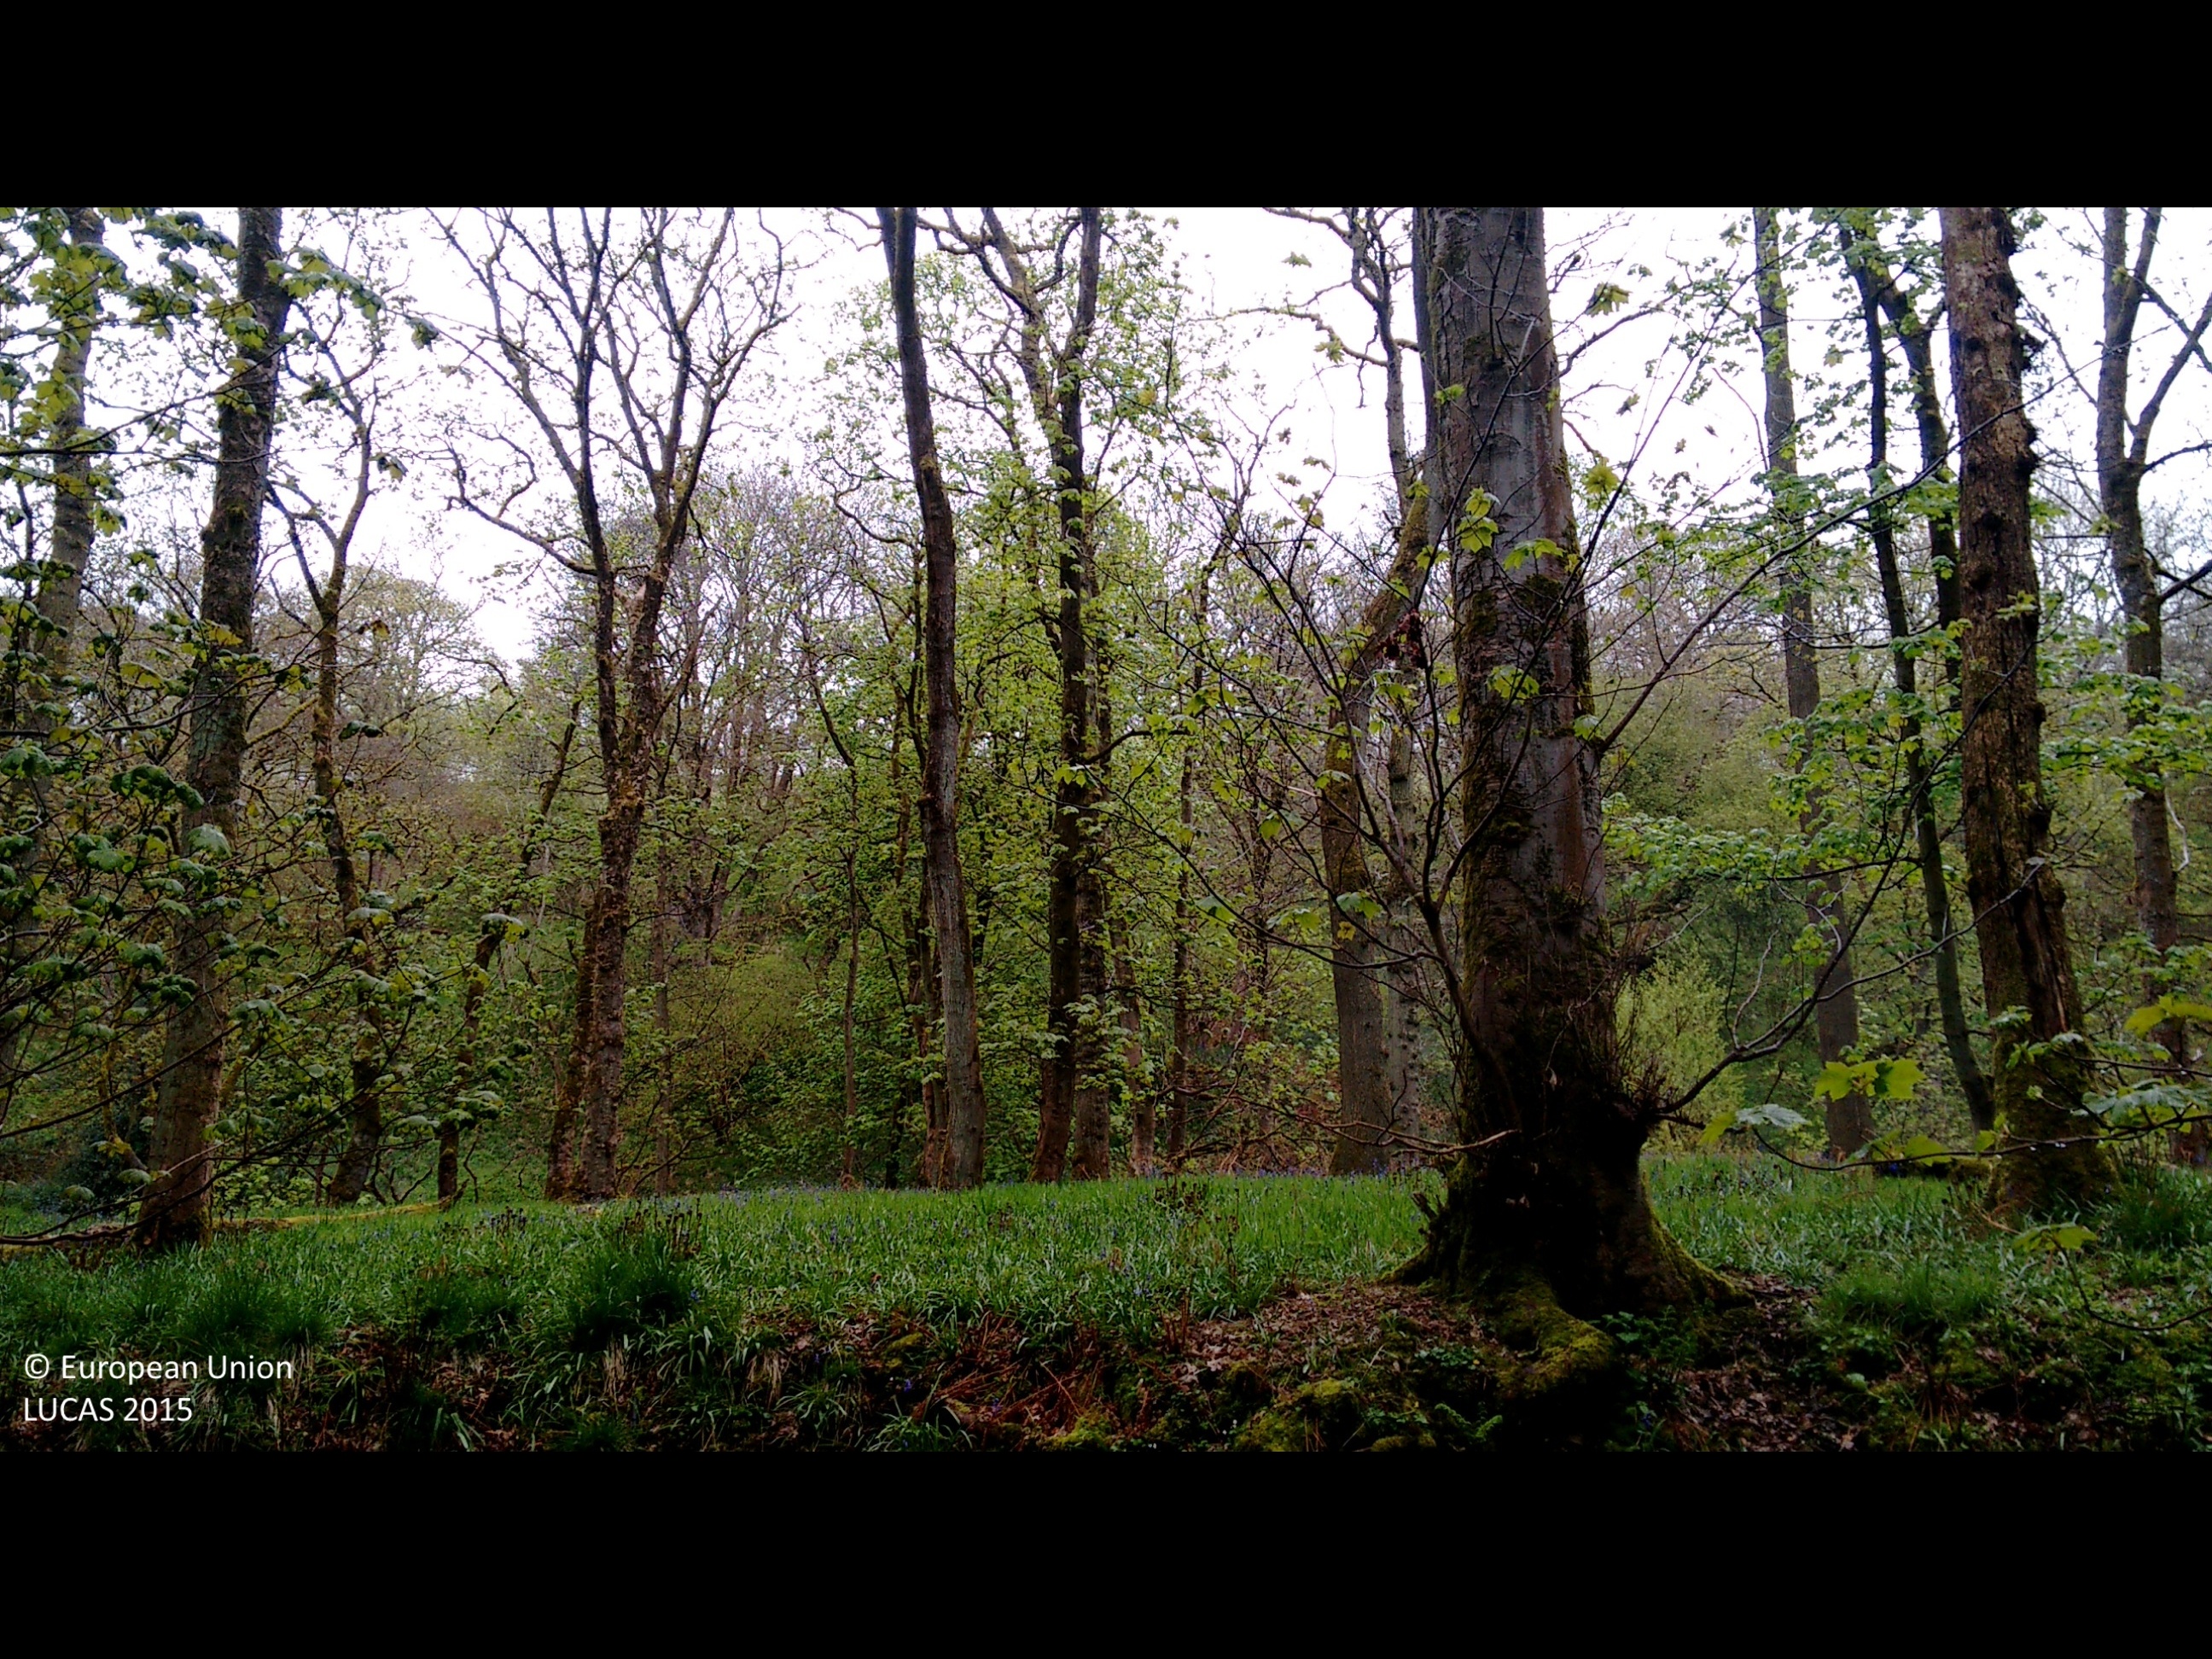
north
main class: Woodland
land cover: Broadleaved woodland
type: mesophytic deciduous forest
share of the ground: > 75 %
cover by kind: broadleaved forest trees 100 %
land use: Amenities, museums, leisure
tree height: > 5 m
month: May
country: GB
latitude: 53.7123
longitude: -2.5353
